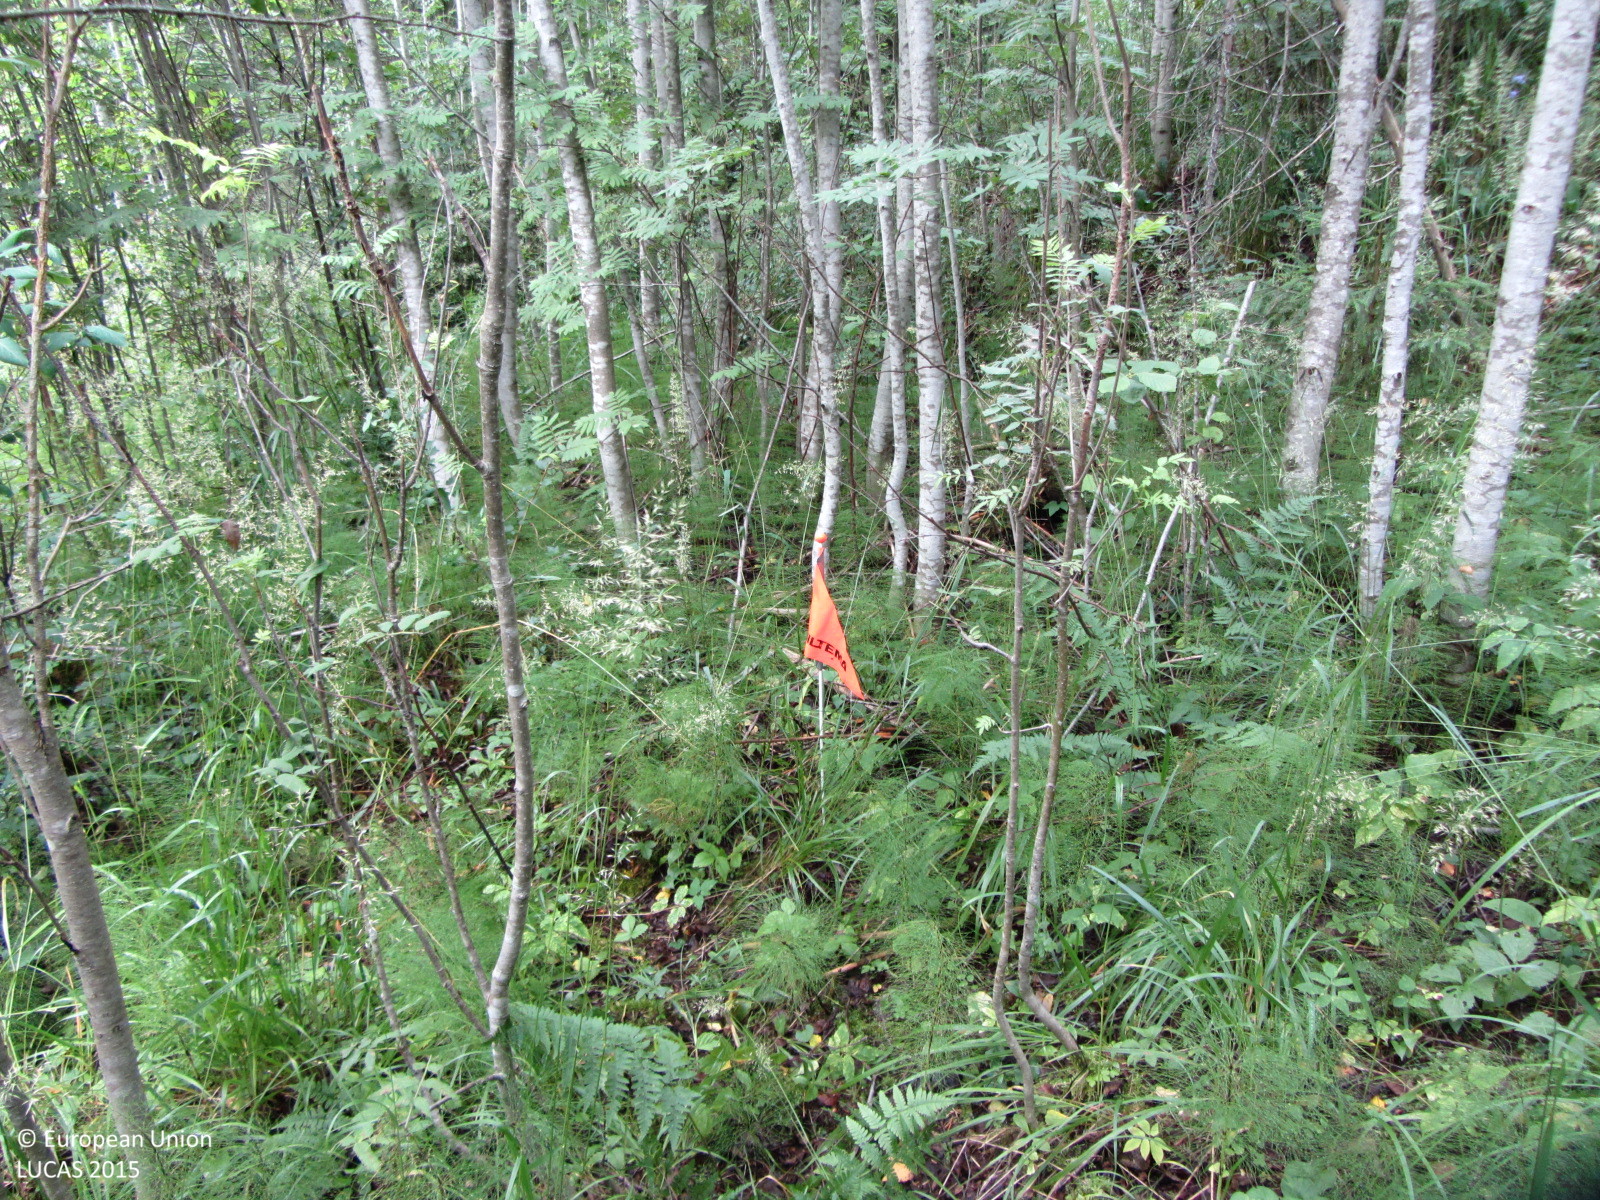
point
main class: Woodland
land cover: Broadleaved woodland
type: boreal forest
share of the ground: > 75 %
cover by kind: broadleaved forest trees 85 %, herbaceous plants 10 %, coniferous forest trees 5 %
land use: Forestry
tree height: > 5 m
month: July
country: FI
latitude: 60.4730
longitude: 24.3092
